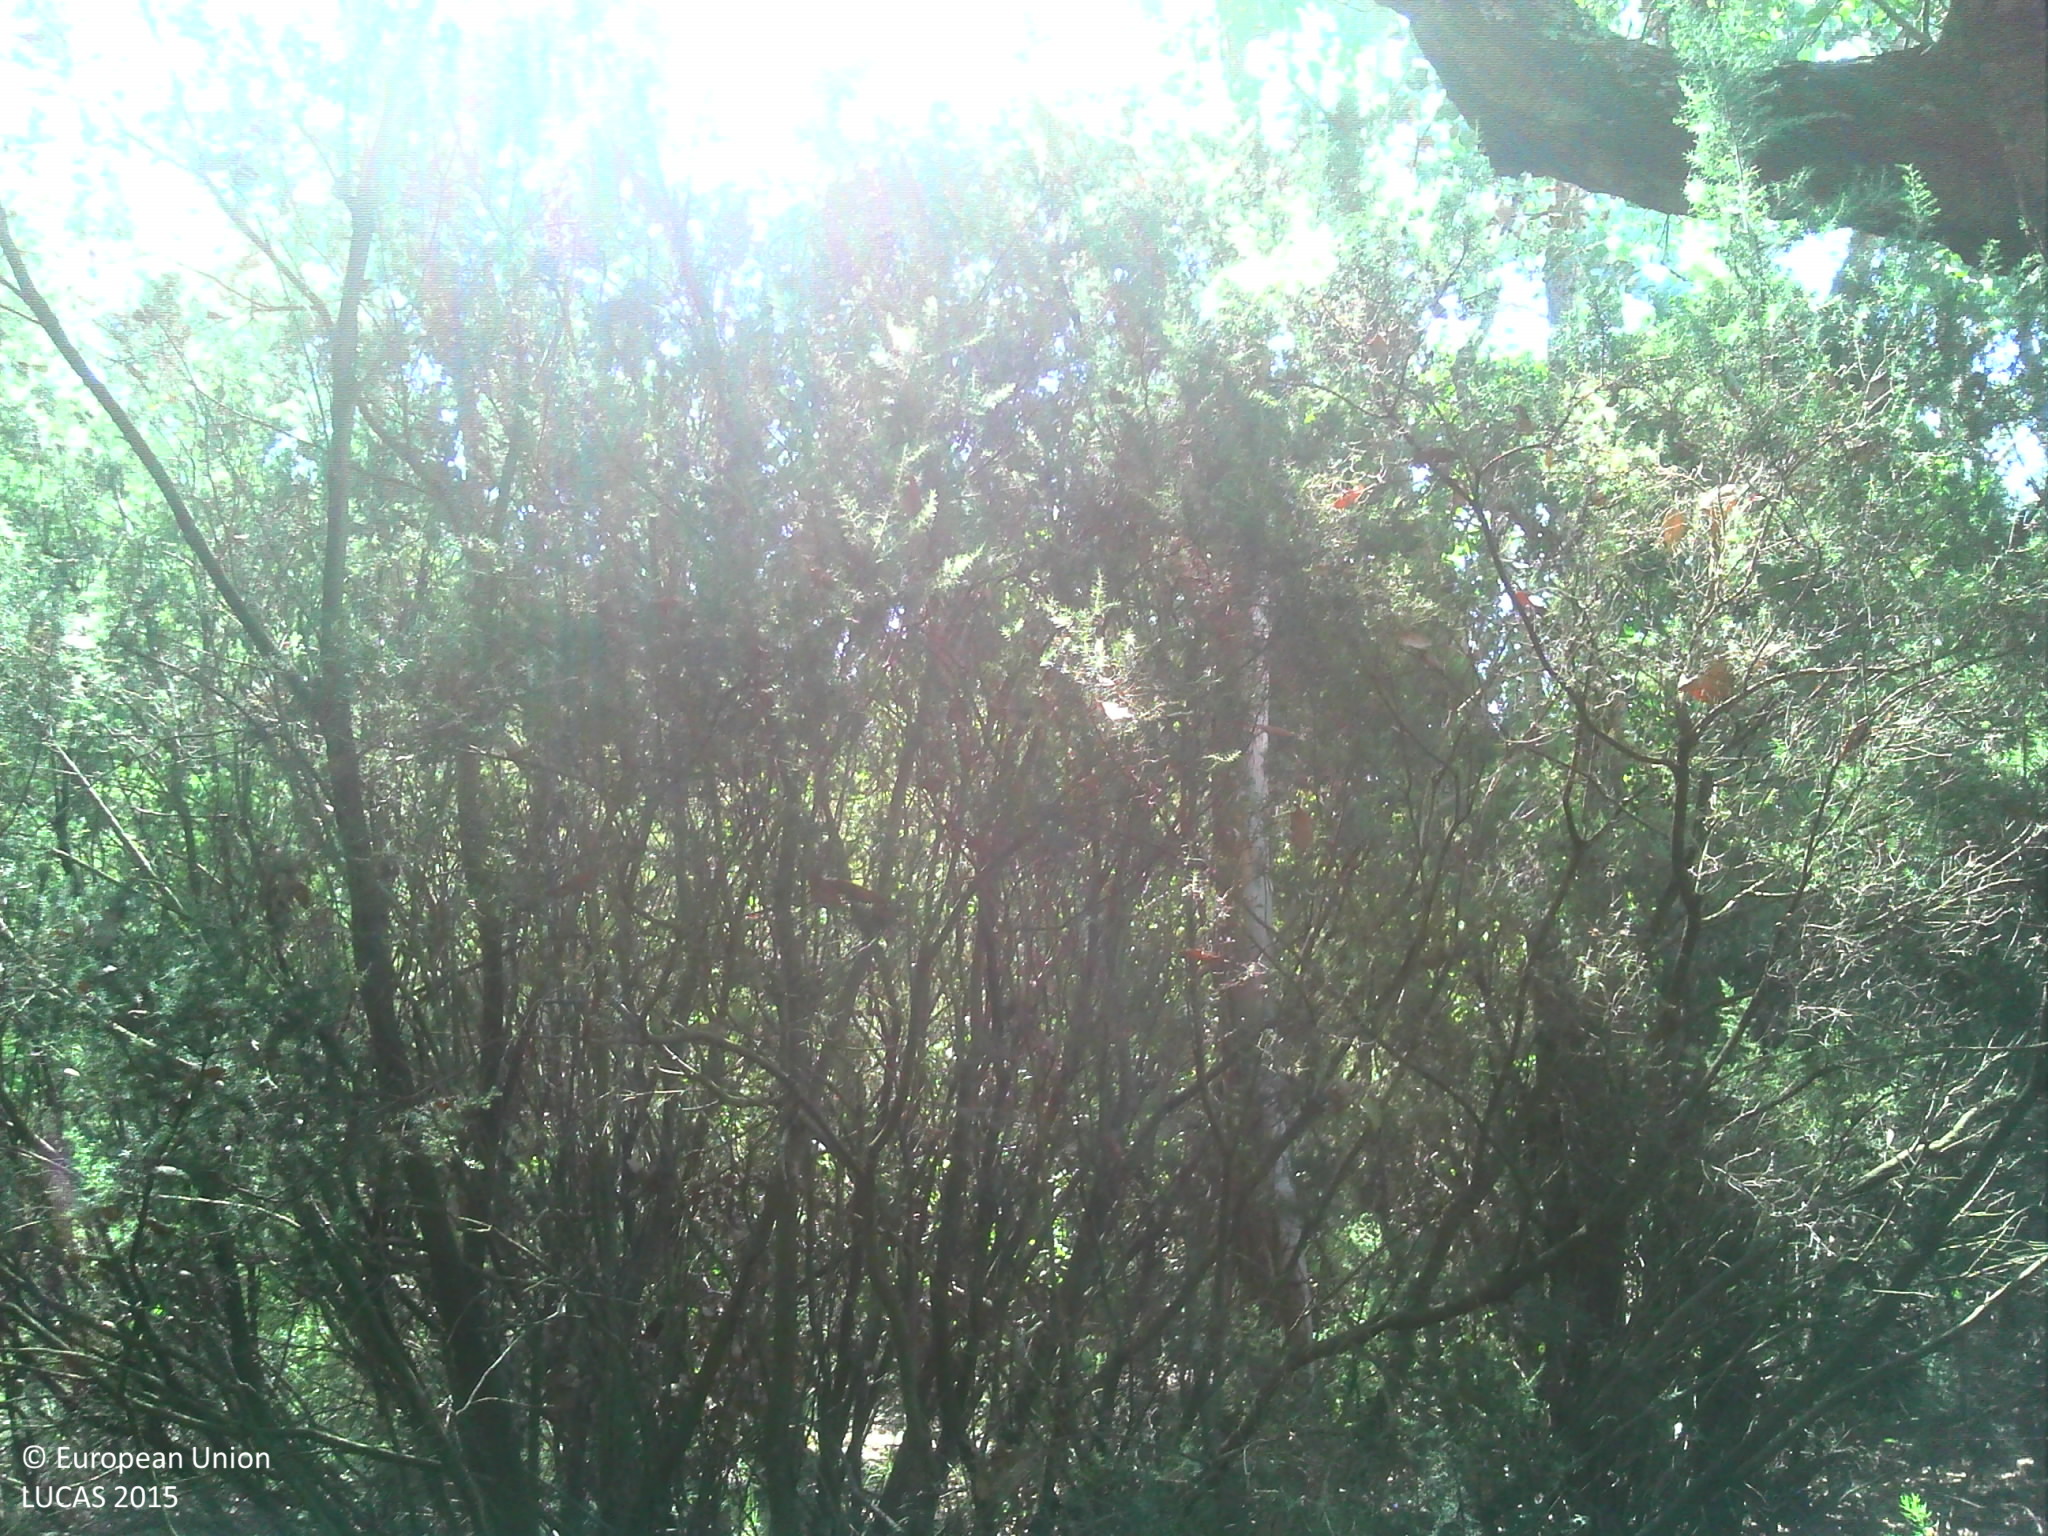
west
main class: Woodland
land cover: Broadleaved woodland
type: thermophilous deciduous forest
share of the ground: > 75 %
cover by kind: broadleaved forest trees 90 %, unconsolidated bare surface 10 %
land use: Semi-natural and natural areas not in use
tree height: > 5 m
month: July
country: FR
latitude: 43.1677
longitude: 6.3809
